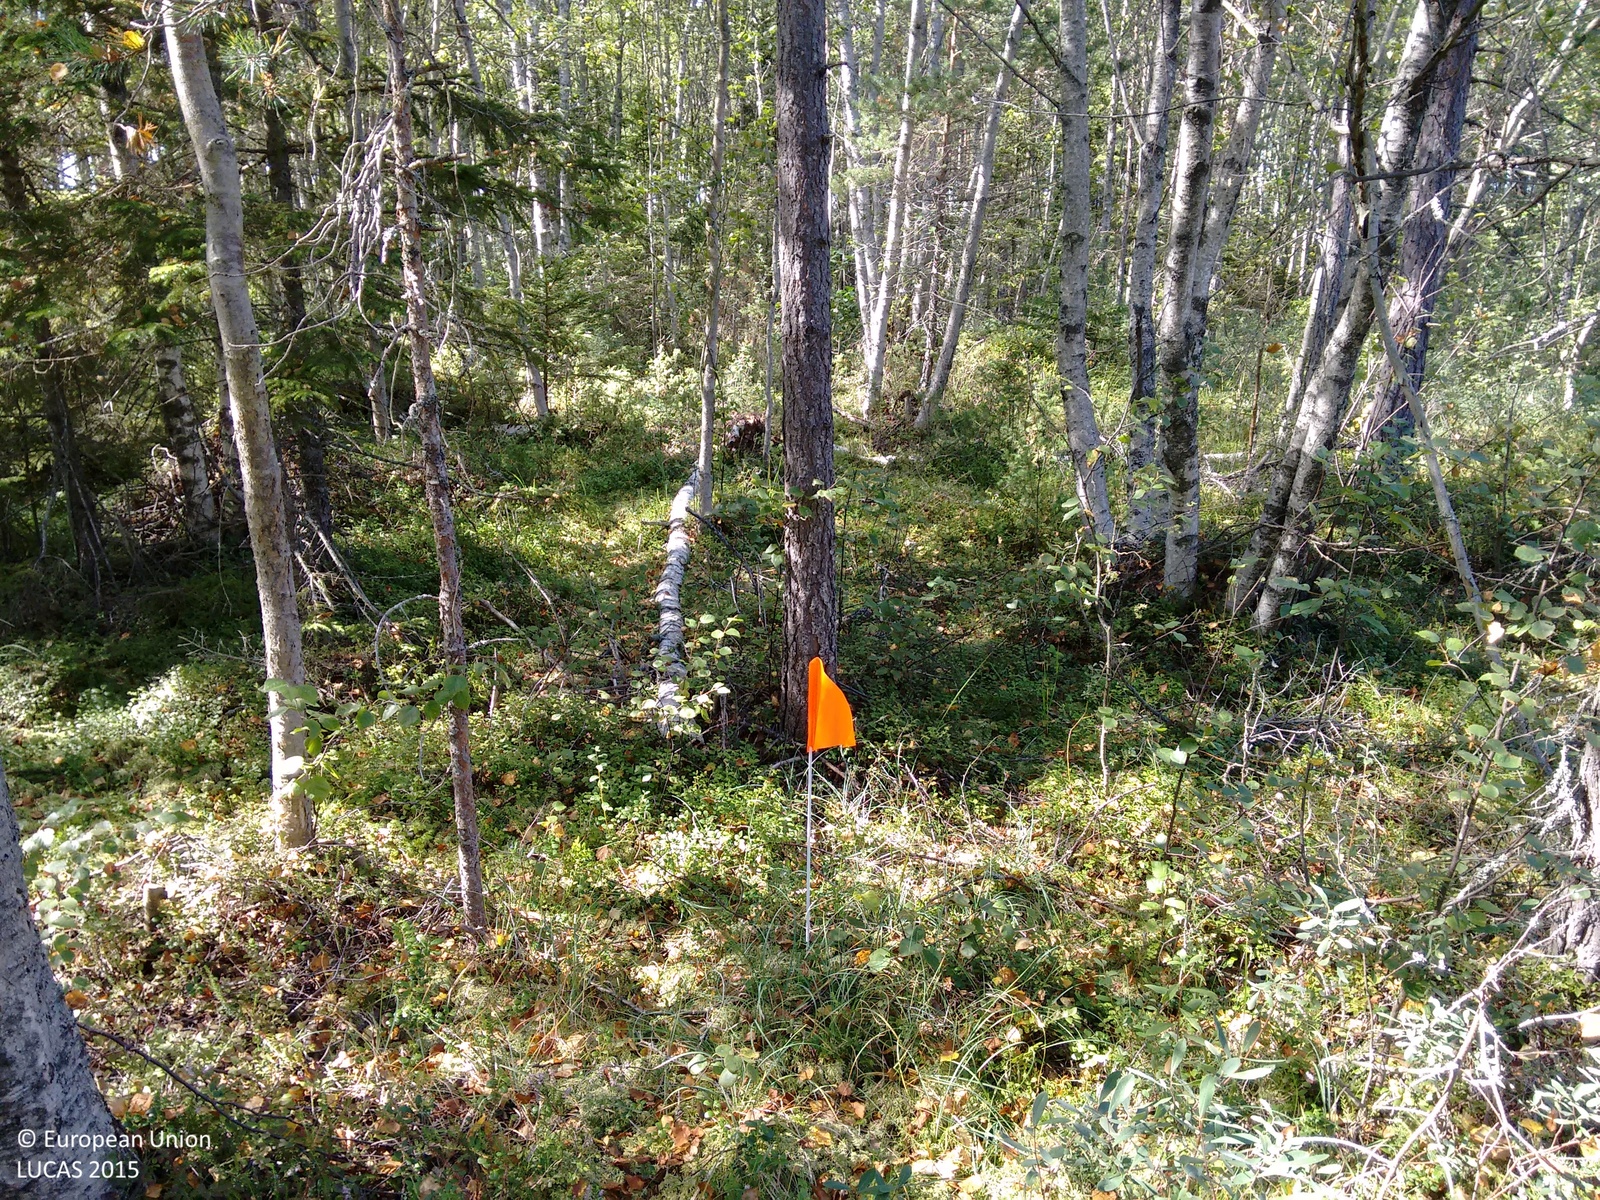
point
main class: Woodland
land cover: Pine dominated mixed woodland
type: hemiboreal forest and nemoral coniferous forest and mixed broadleaved-coniferous forest
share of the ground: > 75 %
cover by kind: coniferous forest trees 60 %, broadleaved forest trees 25 %, shrubs 5 %, herbaceous plants 5 %, lichens and mosses 5 %
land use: Forestry
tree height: > 5 m
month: August
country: FI
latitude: 60.2320
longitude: 19.6279
